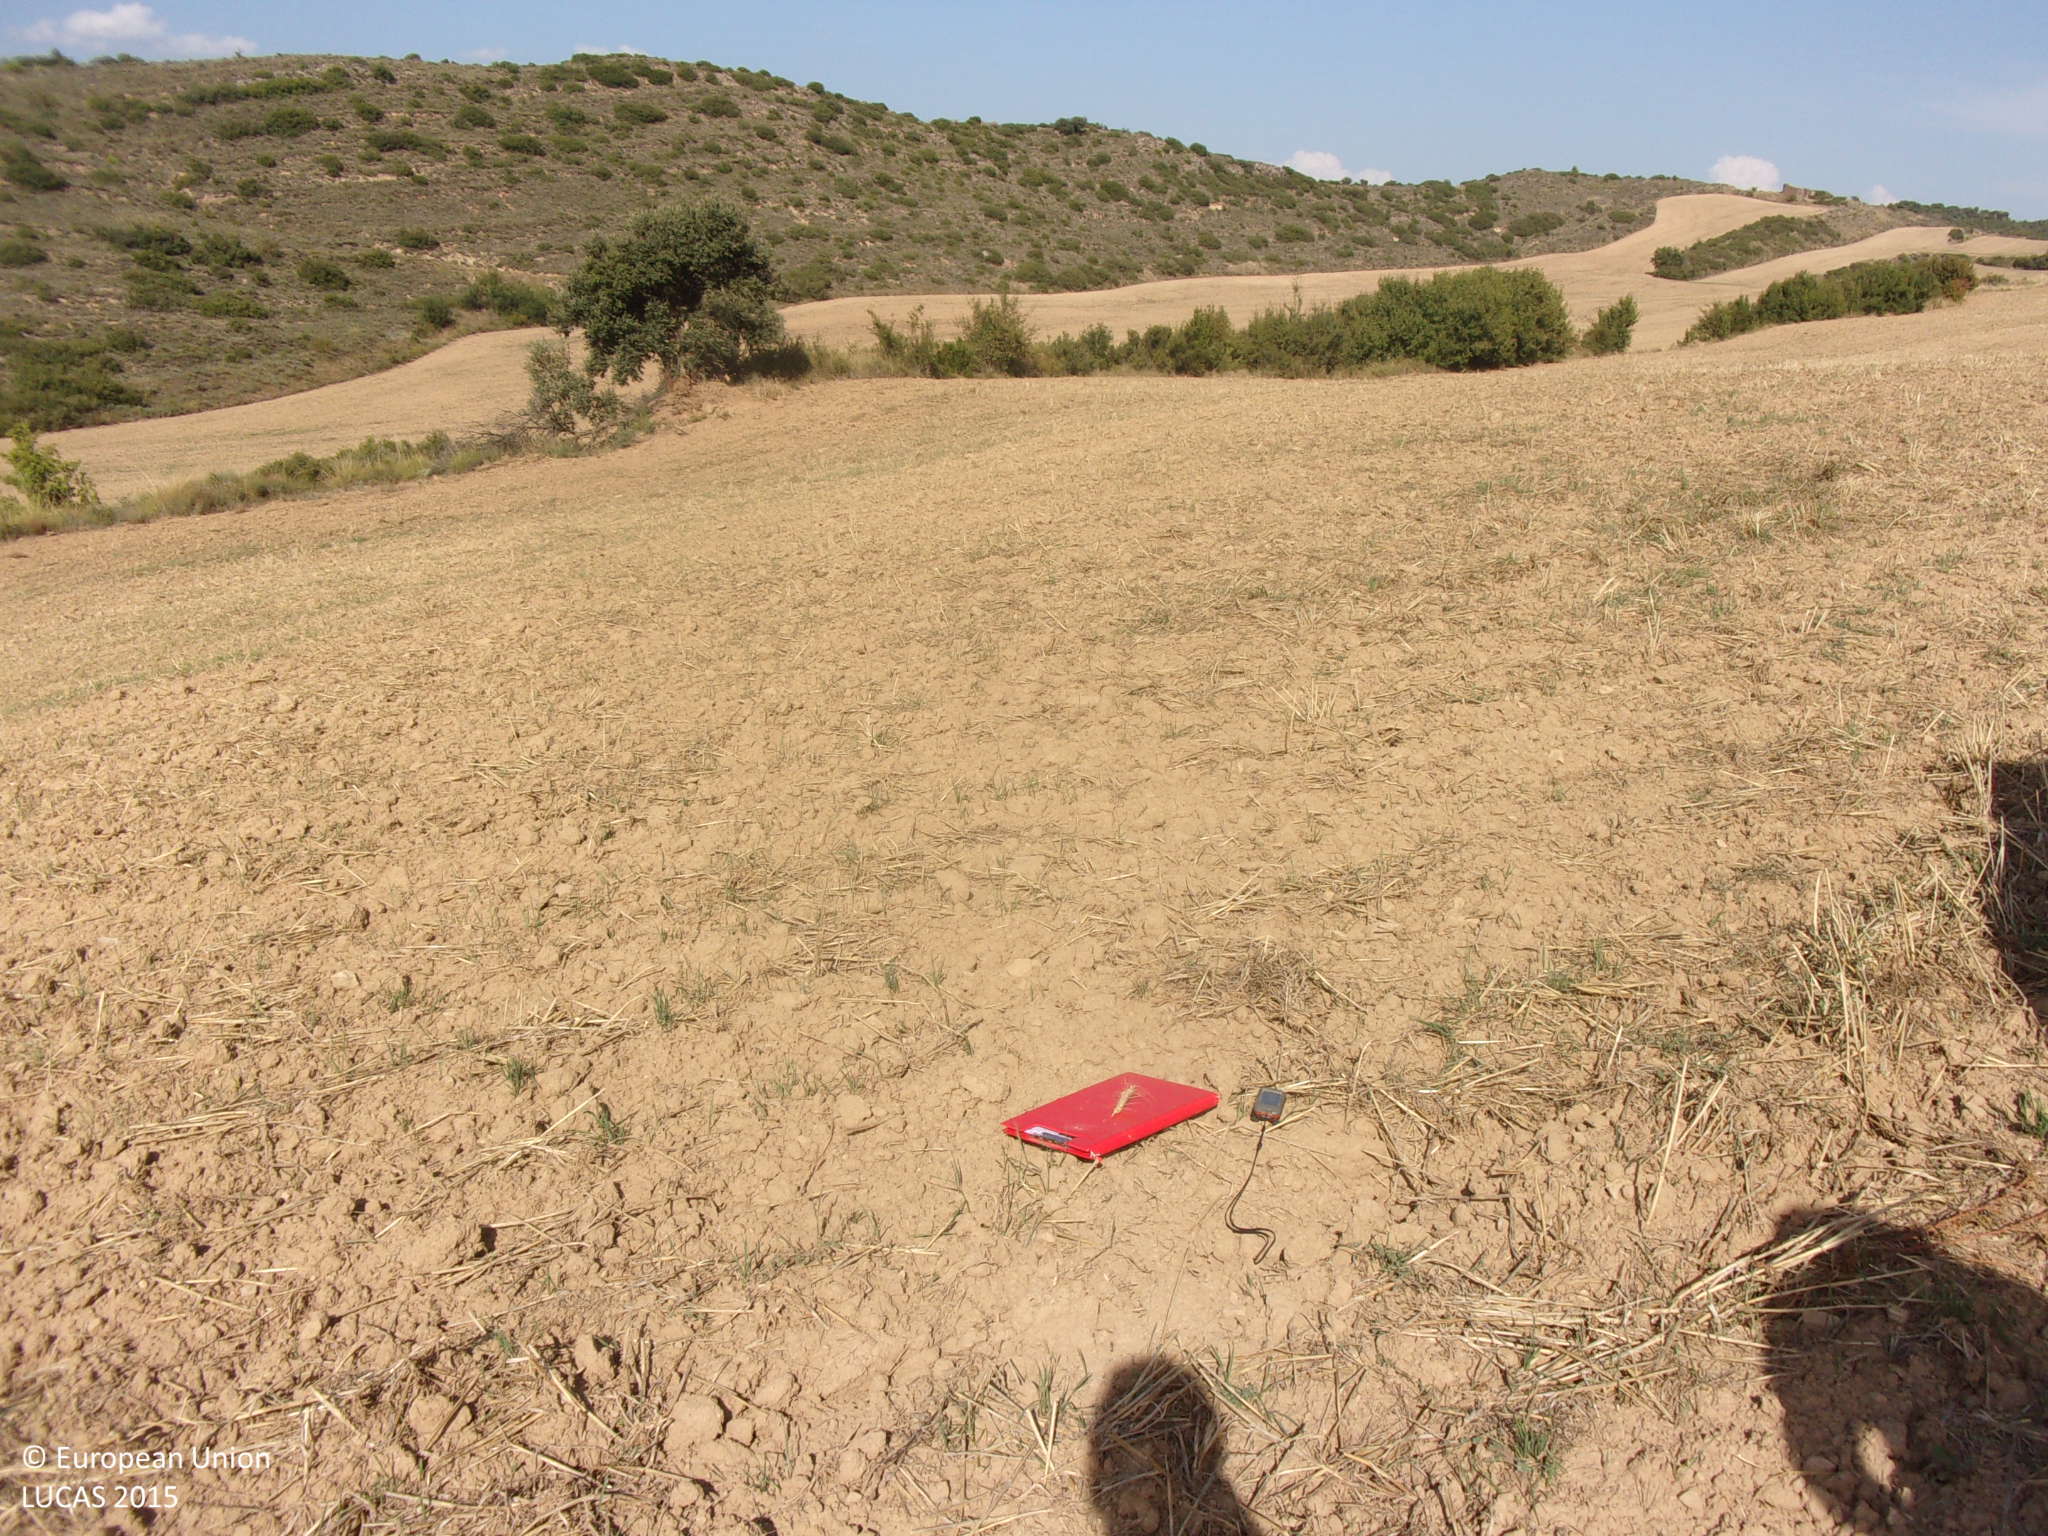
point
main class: Cropland
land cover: Common wheat
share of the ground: < 10 %
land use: Agriculture (excluding fallow land and kitchen gardens)
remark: Harvested field
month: August
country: ES
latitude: 42.5053
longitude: -1.1915
